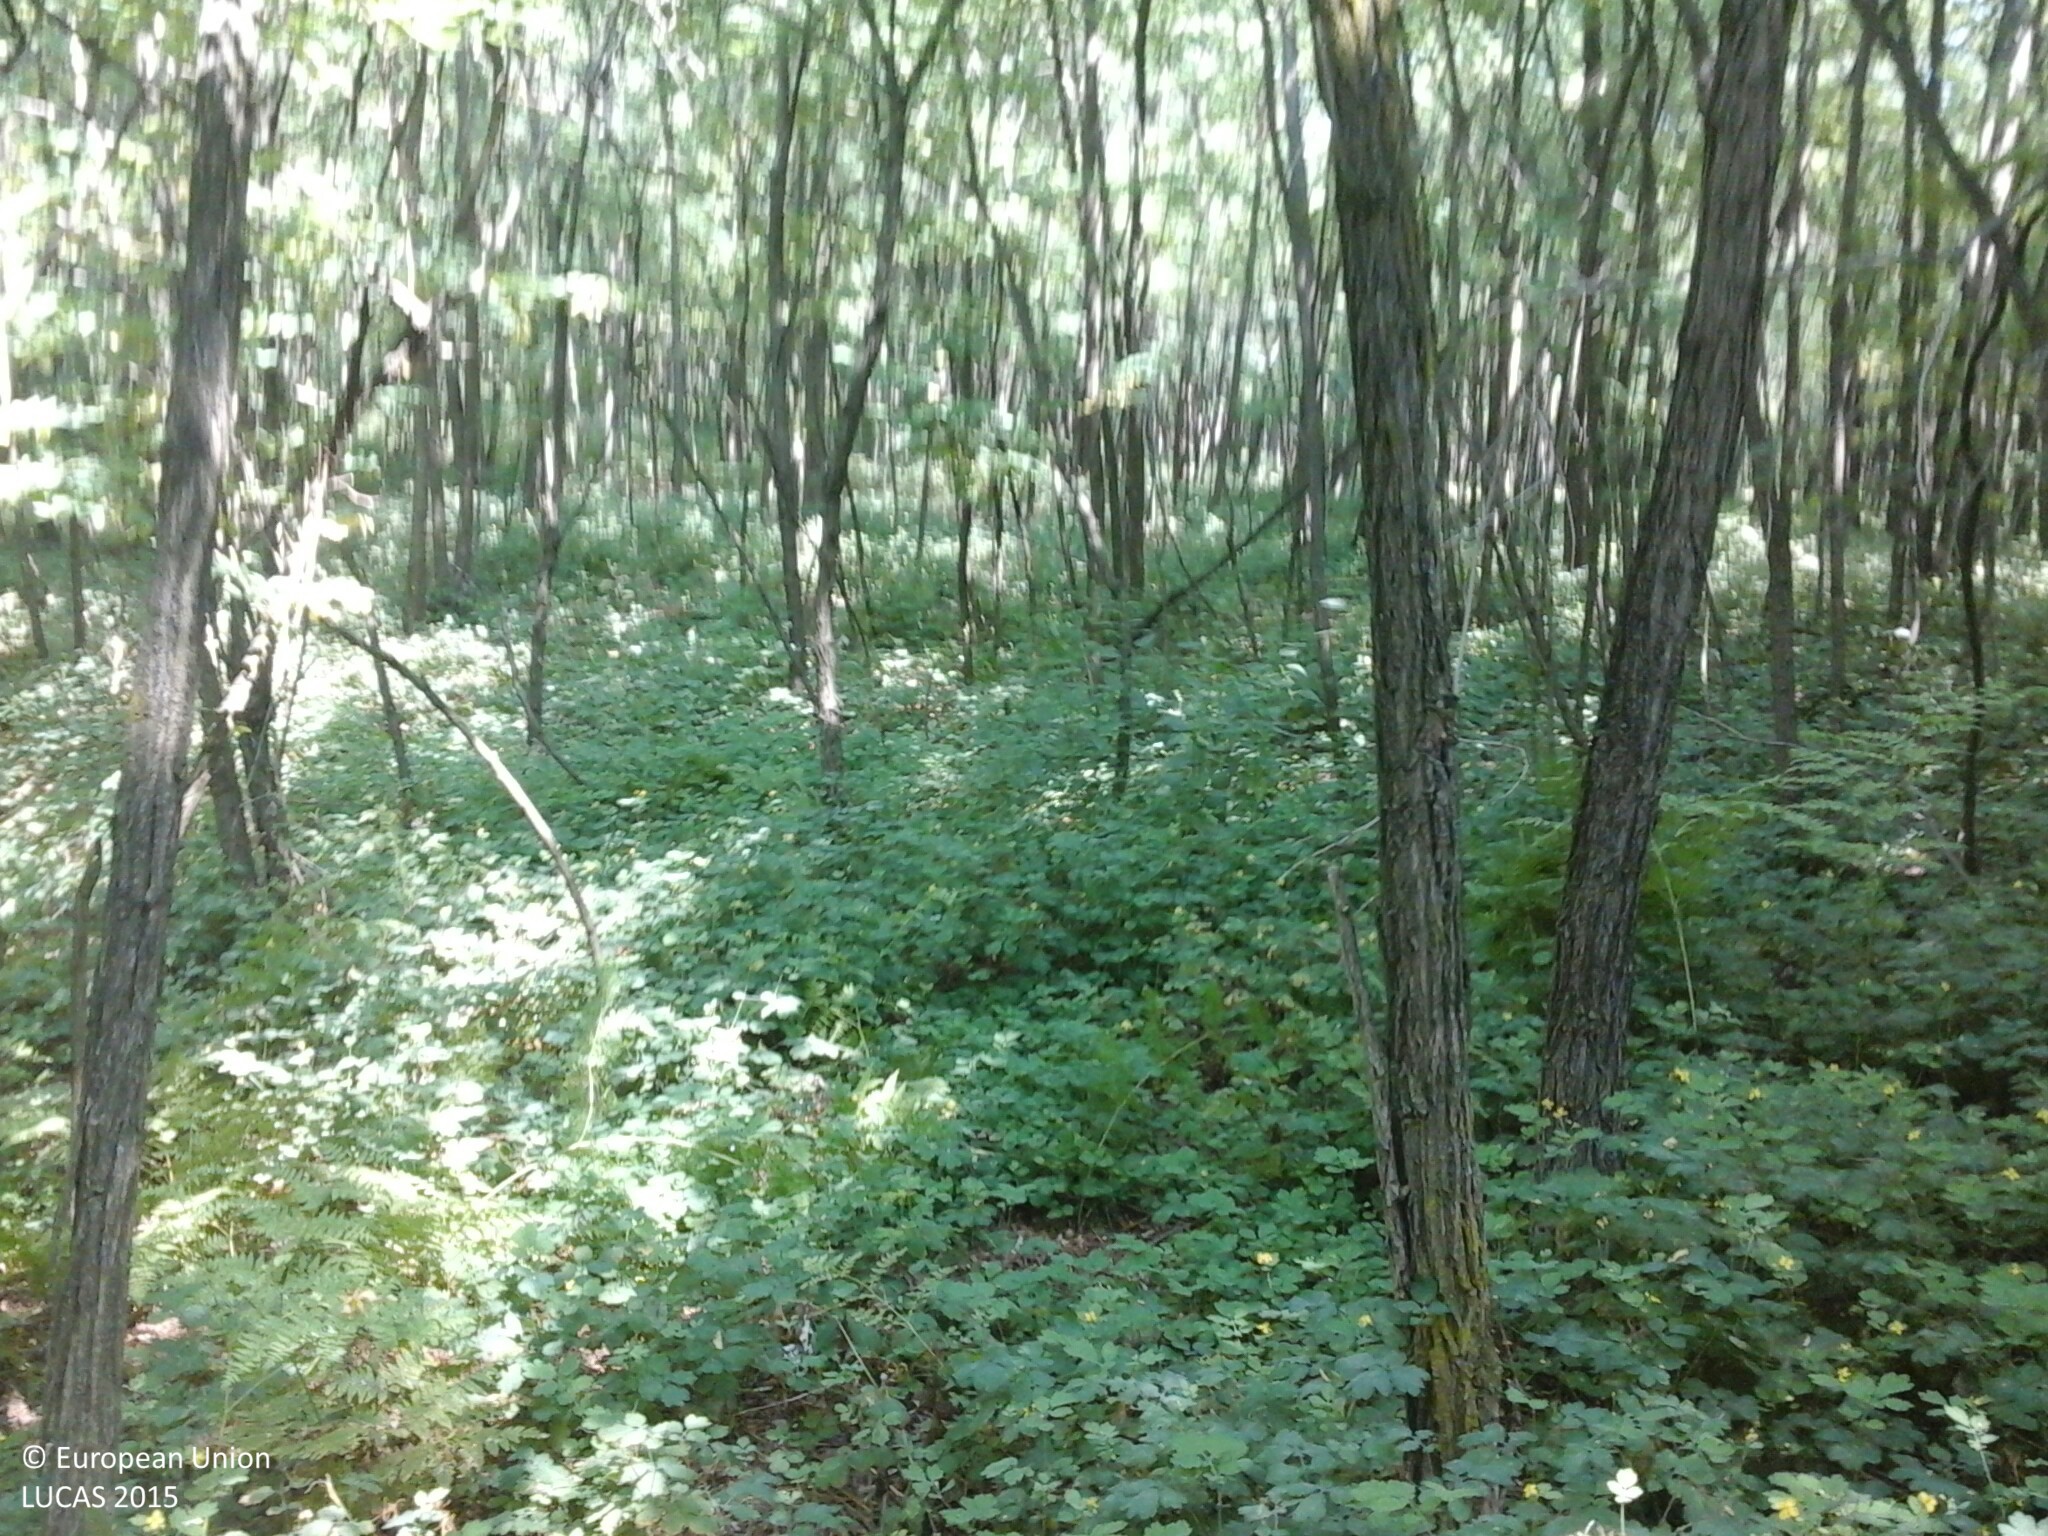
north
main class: Woodland
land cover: Broadleaved woodland
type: exotic forest
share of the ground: > 75 %
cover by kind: broadleaved forest trees 100 %
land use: Forestry
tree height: > 5 m
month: July
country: HU
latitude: 48.1414
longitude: 22.2184
